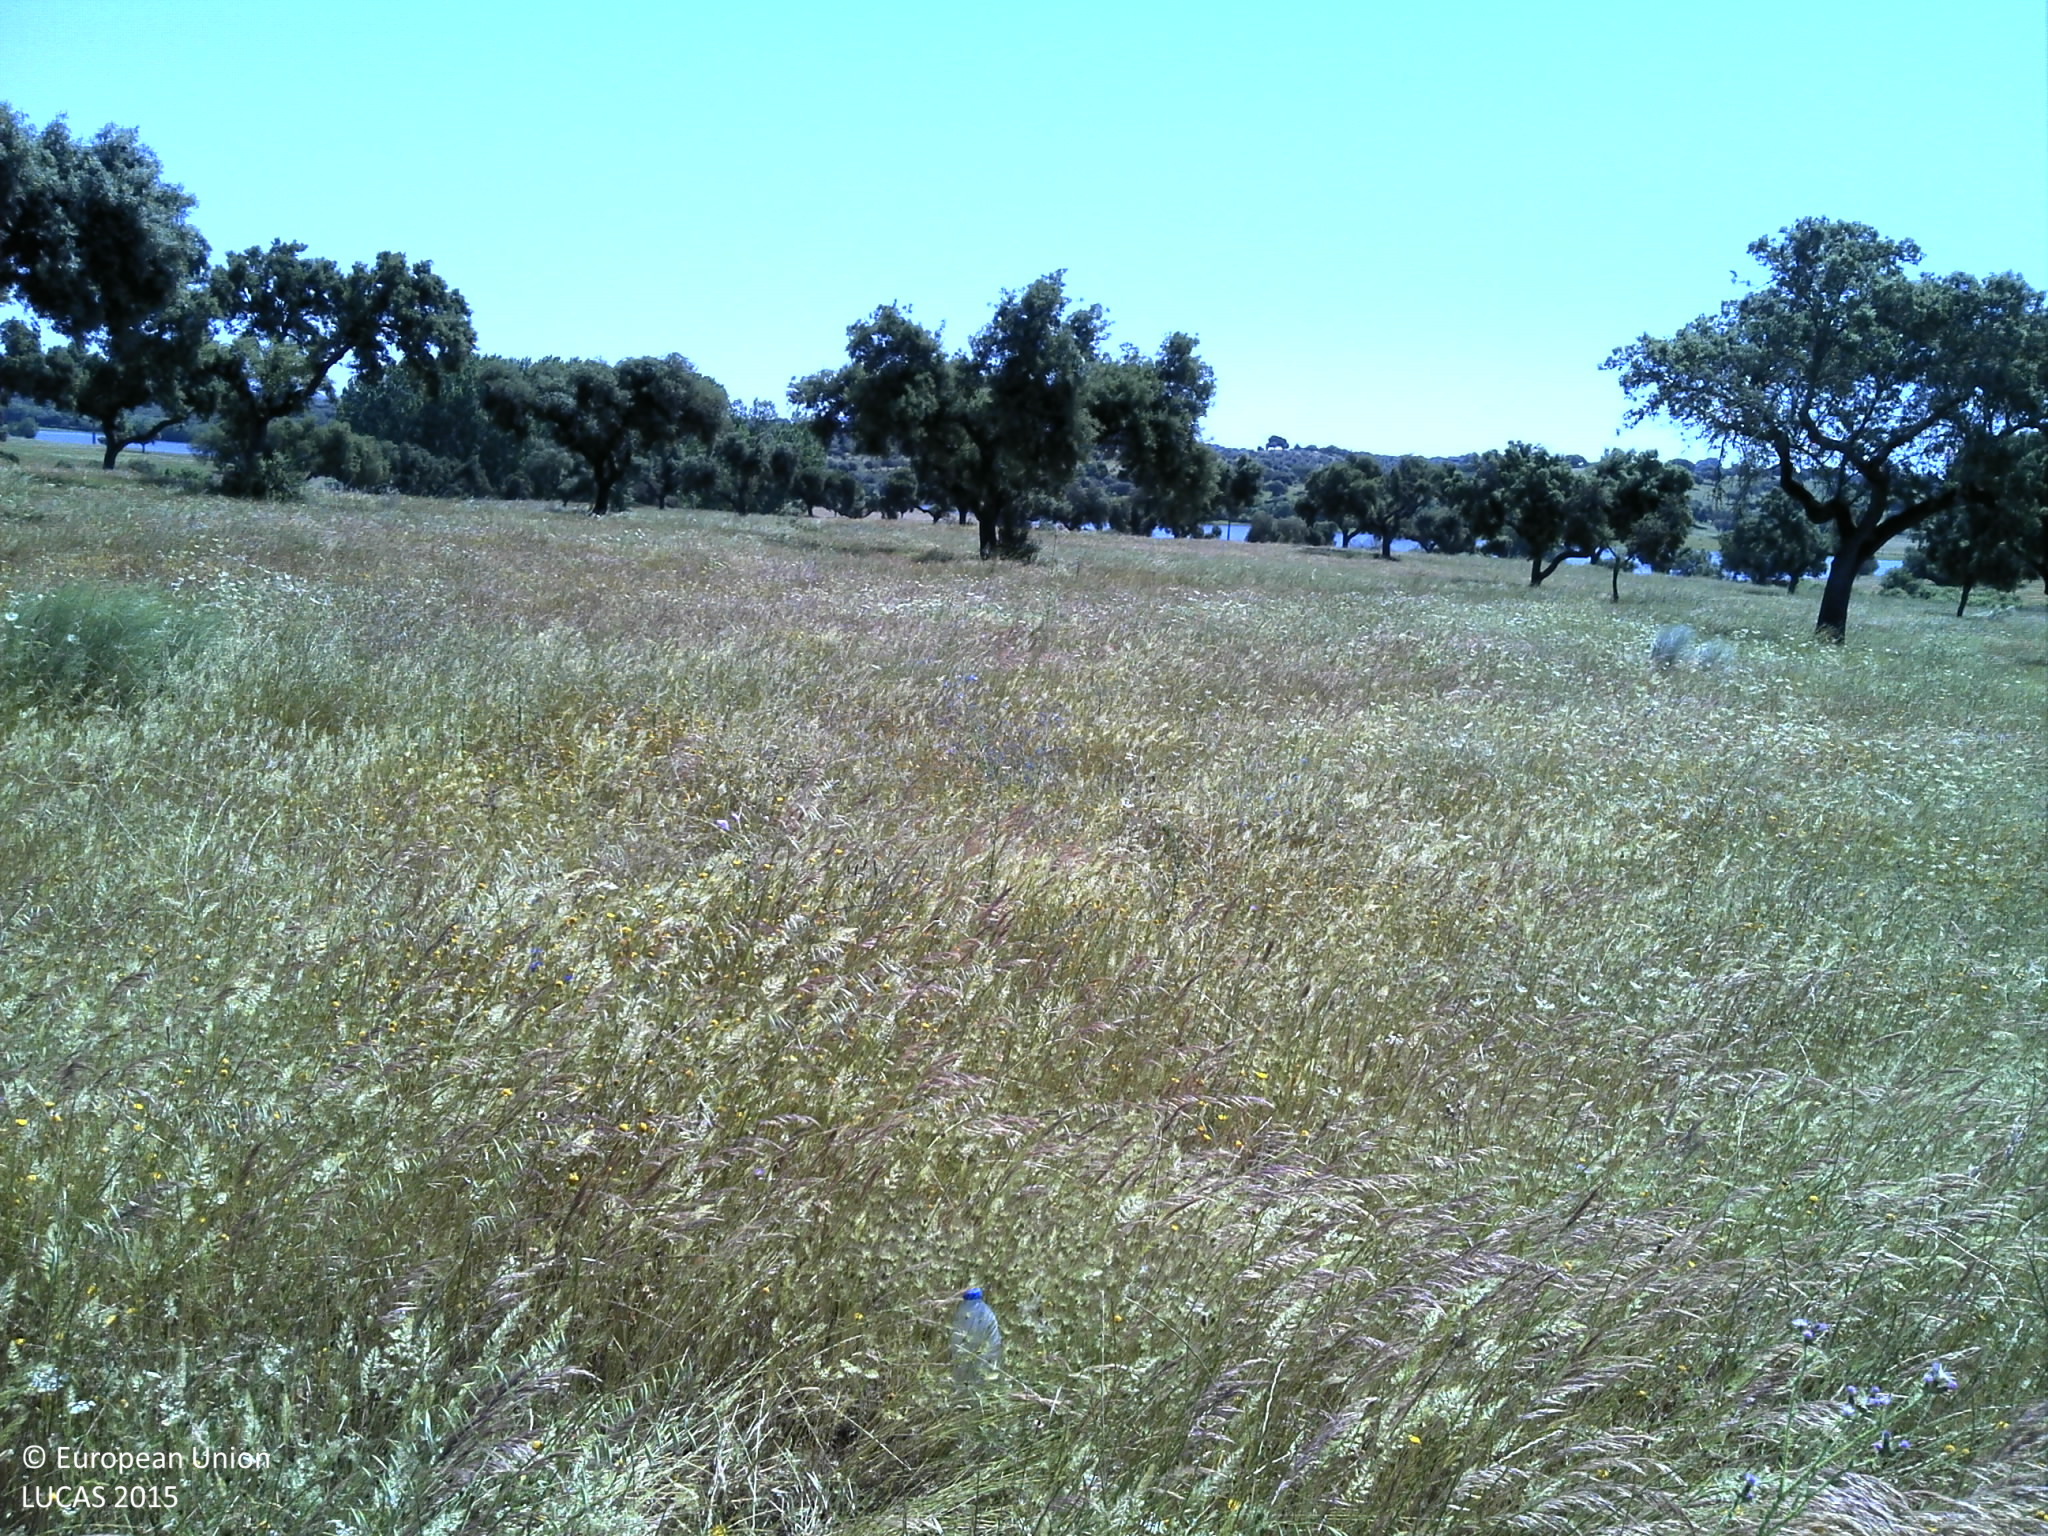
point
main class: Grassland
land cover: Grassland with sparse tree/shrub cover
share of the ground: > 75 %
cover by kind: herbaceous plants 90 %, broadleaved forest trees 5 %, unconsolidated bare surface 5 %
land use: Agriculture (excluding fallow land and kitchen gardens)
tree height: > 5 m
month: May
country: PT
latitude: 39.1499
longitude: -7.8571
